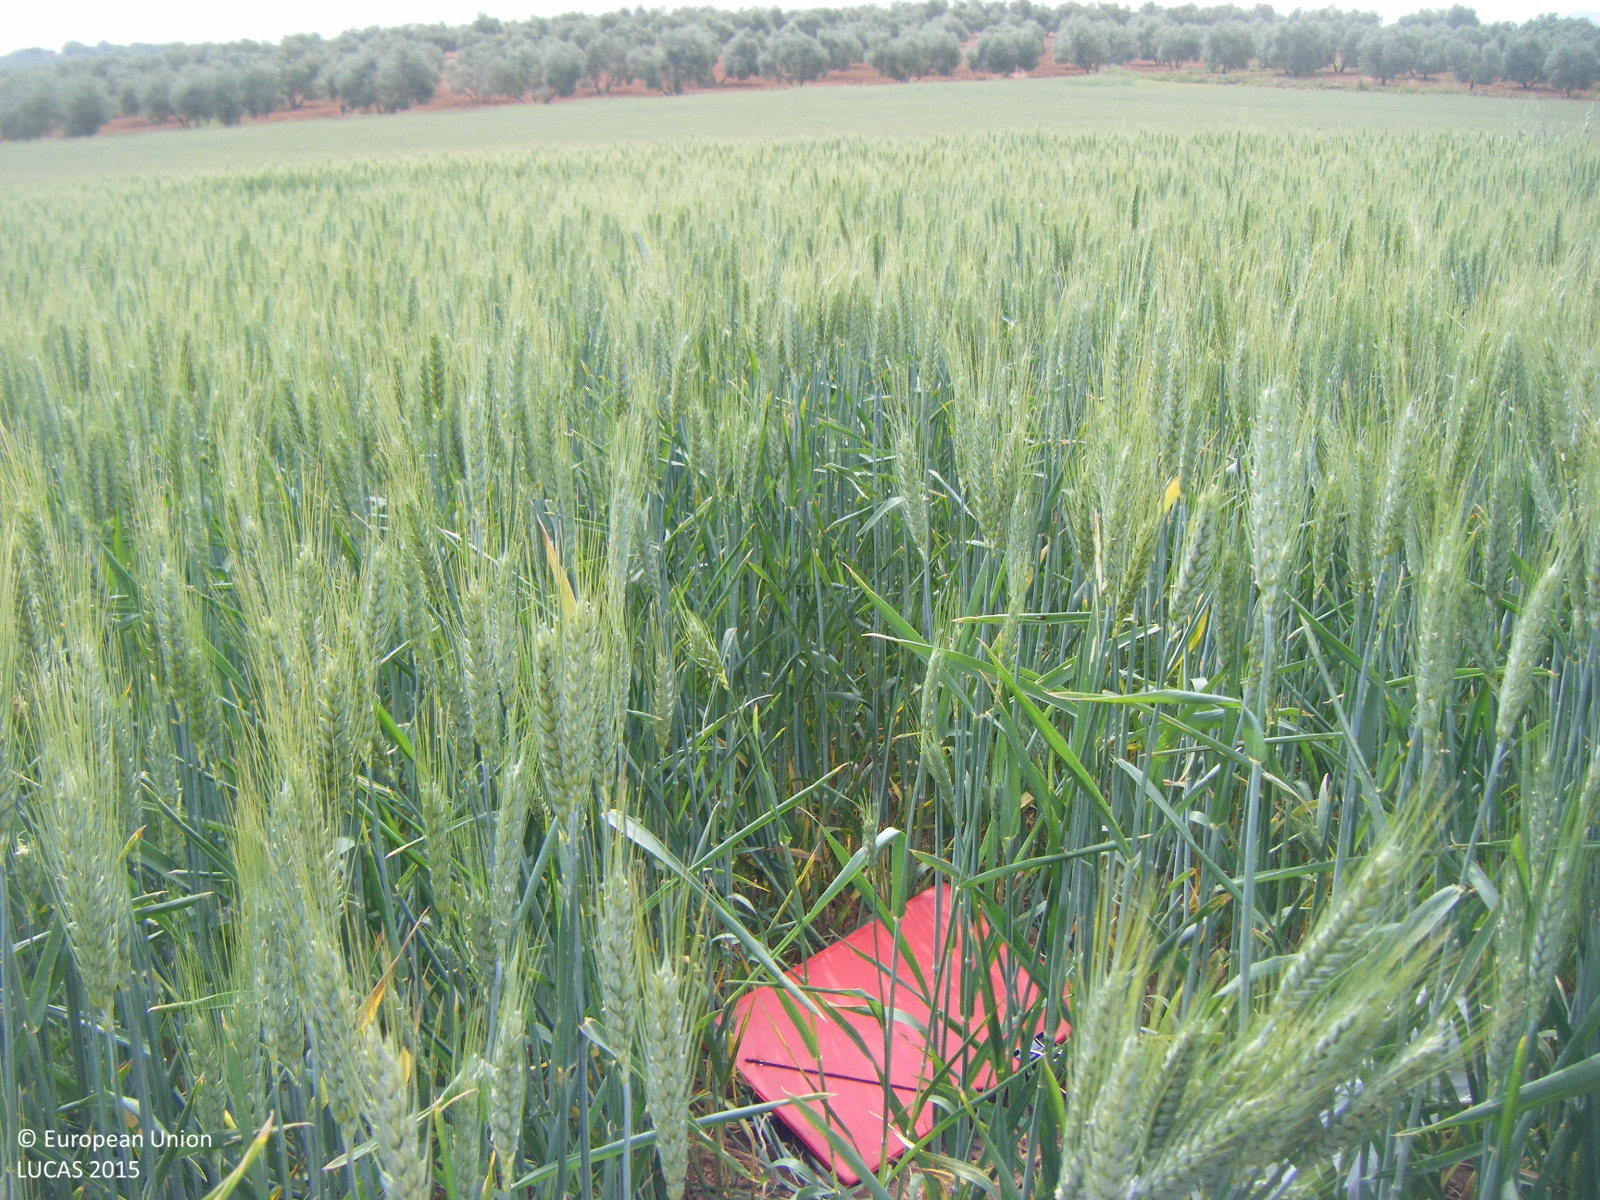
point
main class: Cropland
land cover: Durum wheat
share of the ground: > 75 %
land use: Agriculture (excluding fallow land and kitchen gardens)
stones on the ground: < 10 %
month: April
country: ES
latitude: 37.0840
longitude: -4.7709
